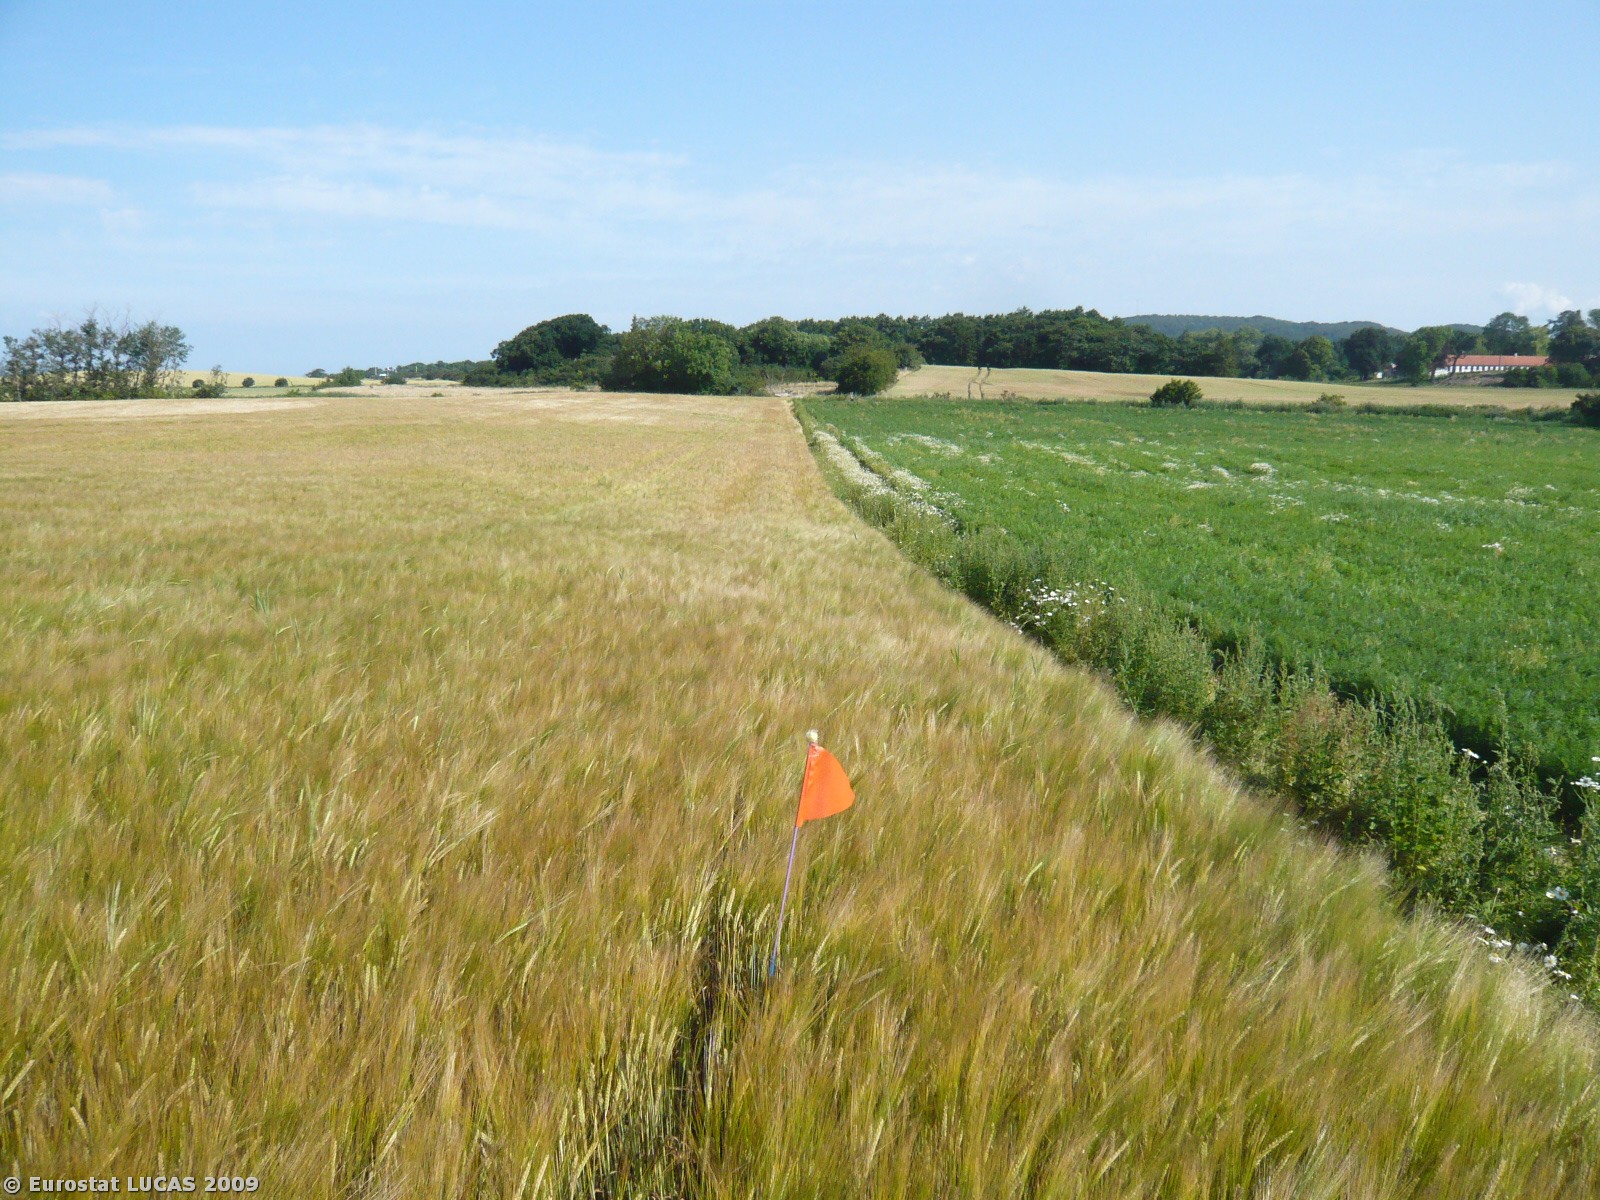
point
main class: Cropland
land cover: Barley
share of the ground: > 75 %
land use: Agriculture (excluding fallow land and kitchen gardens)
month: July
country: DK
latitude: 55.7668
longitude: 11.3853
